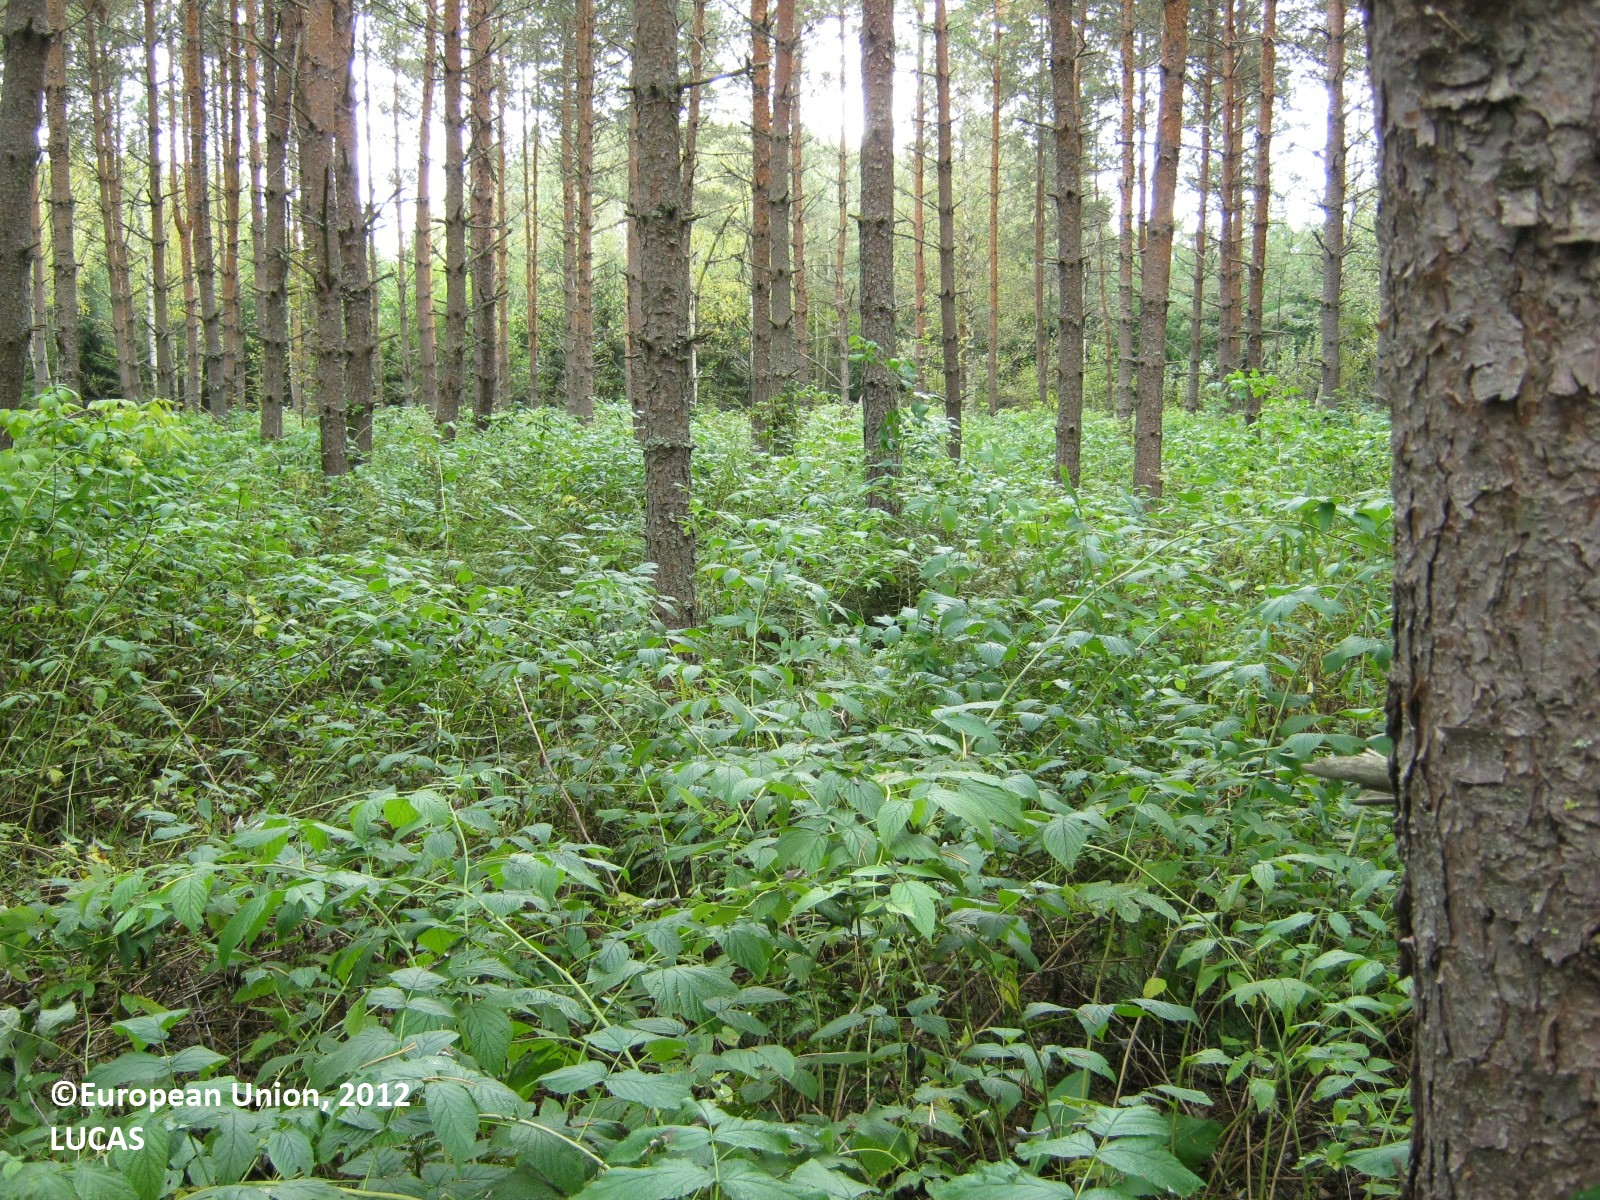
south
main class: Woodland
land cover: Spruce dominated mixed woodland
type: boreal forest
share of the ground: > 75 %
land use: Forestry
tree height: > 5 m
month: September
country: FI
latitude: 60.6845
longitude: 27.7902
